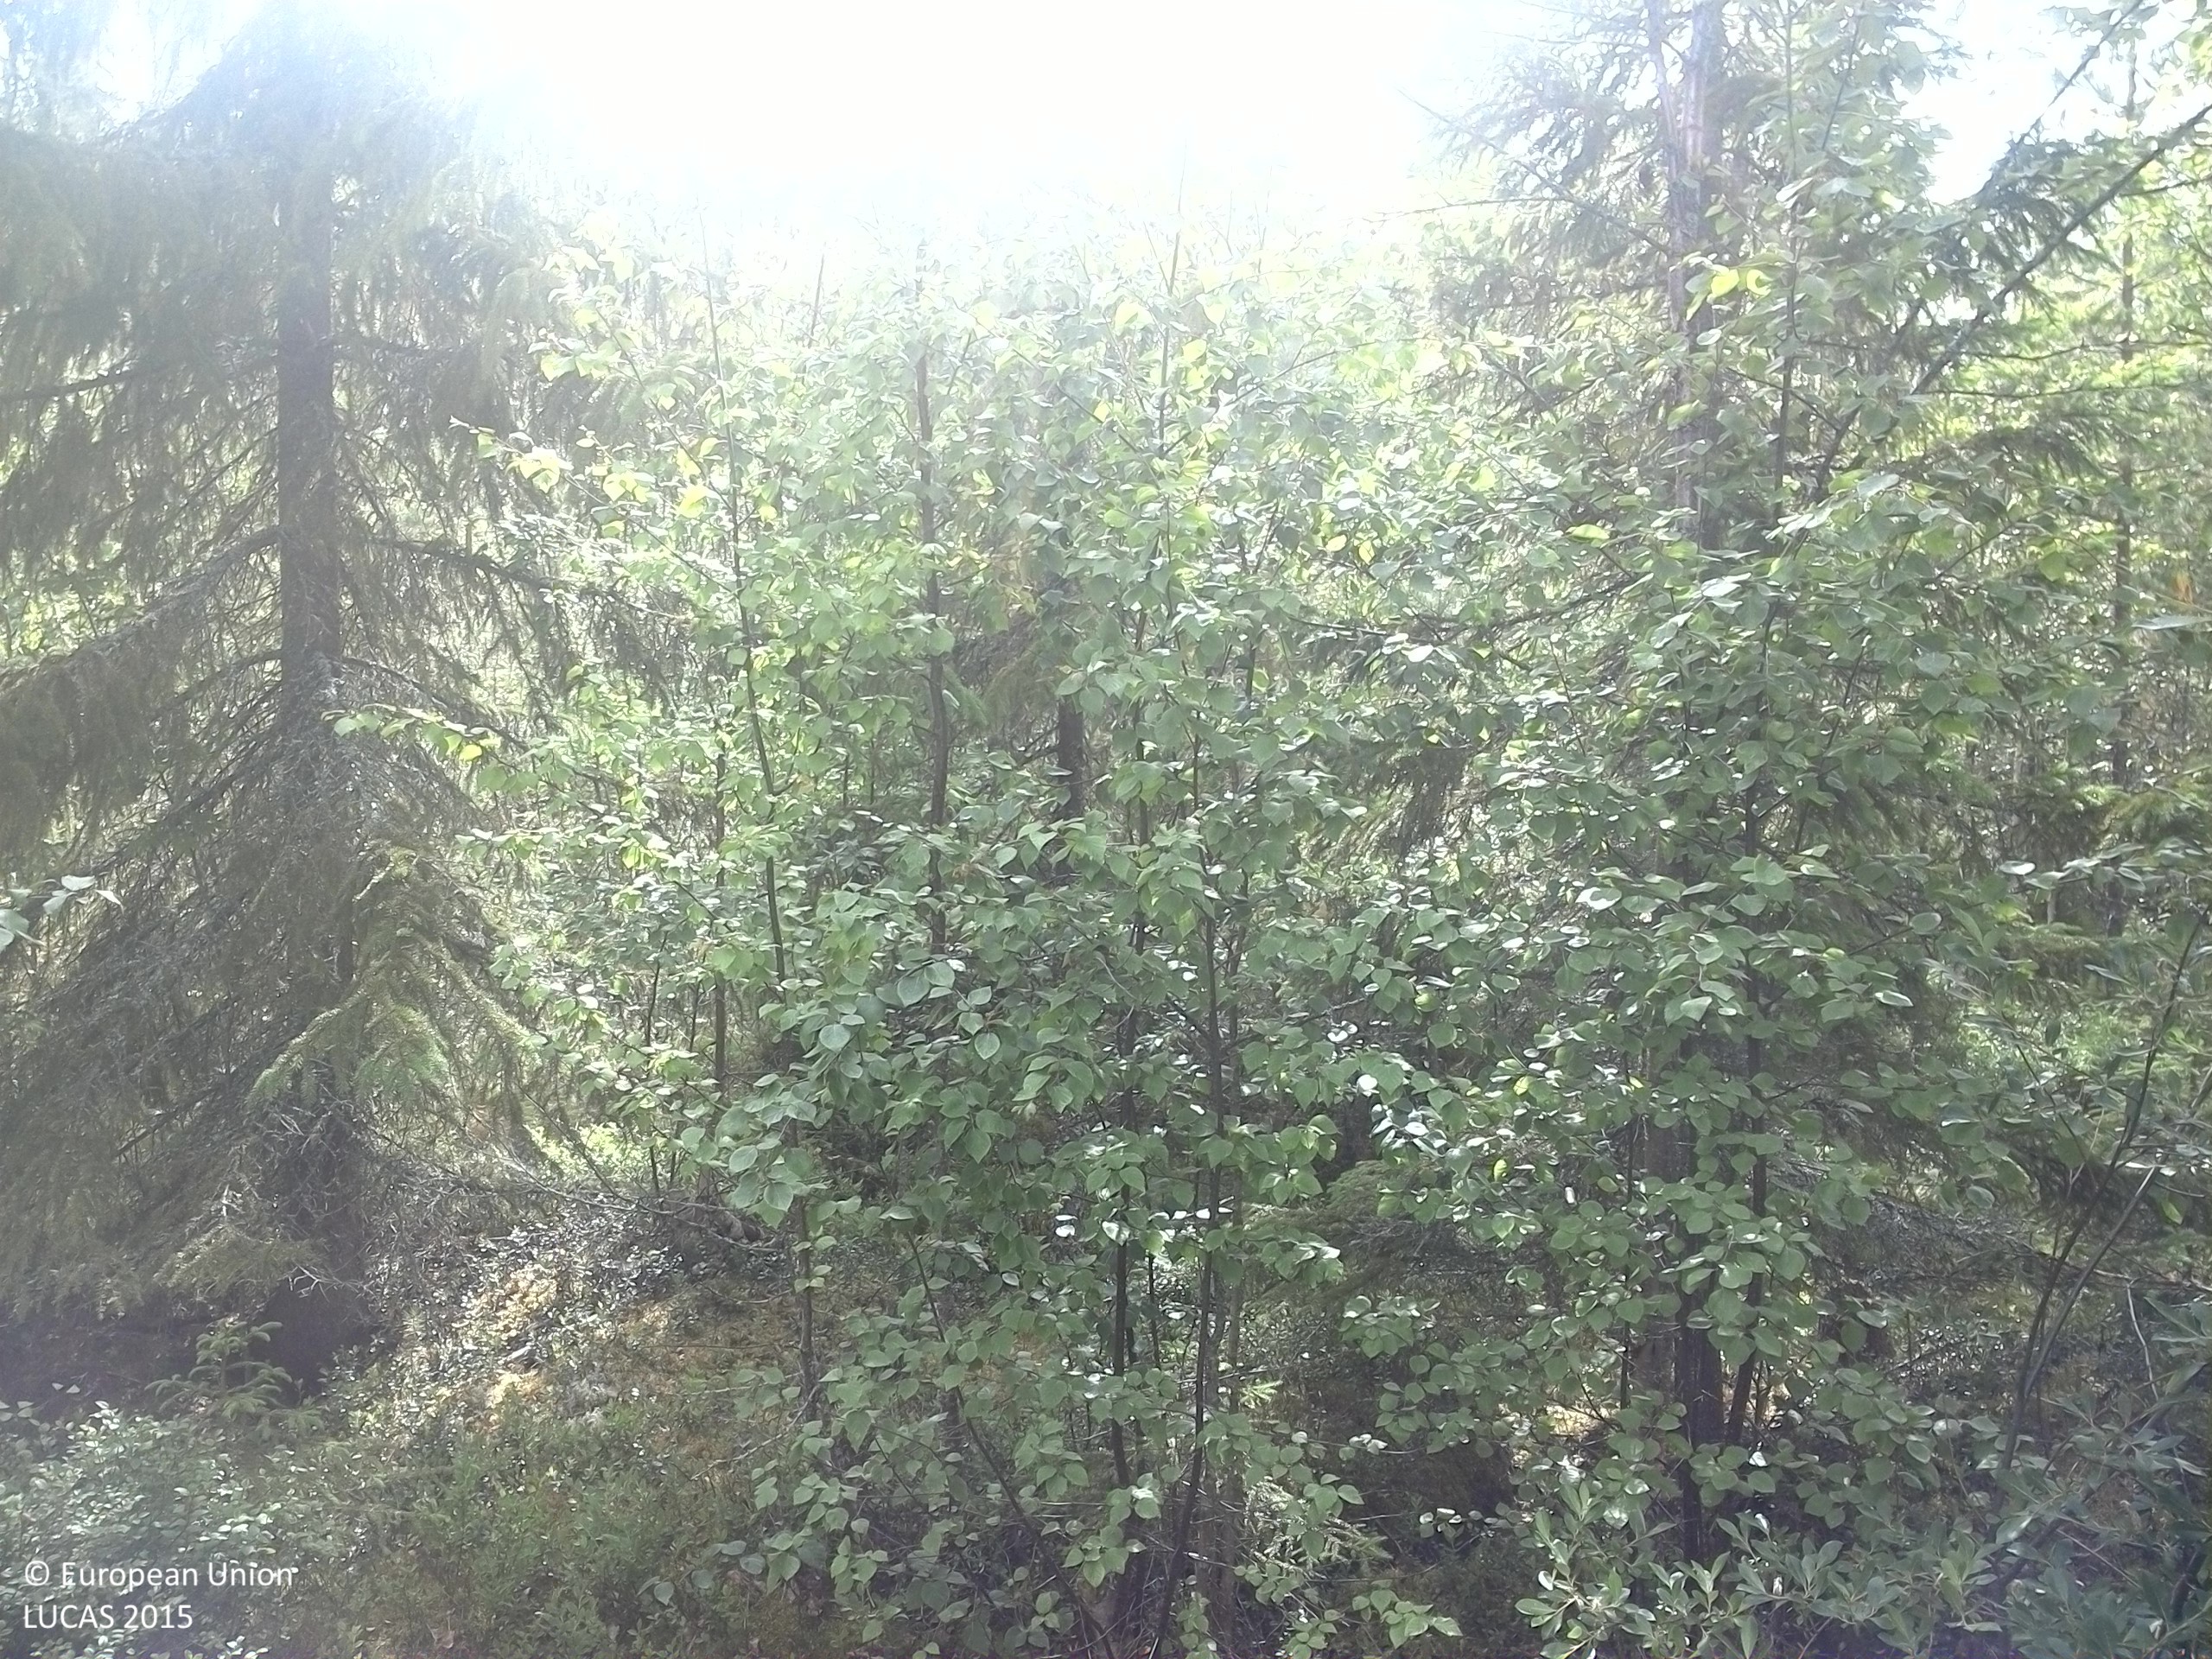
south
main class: Woodland
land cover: Spruce dominated mixed woodland
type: boreal forest
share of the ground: > 75 %
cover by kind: coniferous forest trees 60 %, broadleaved forest trees 30 %, shrubs 10 %
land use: Forestry
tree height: < 5 m
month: July
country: SE
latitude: 63.5864
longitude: 17.8520
